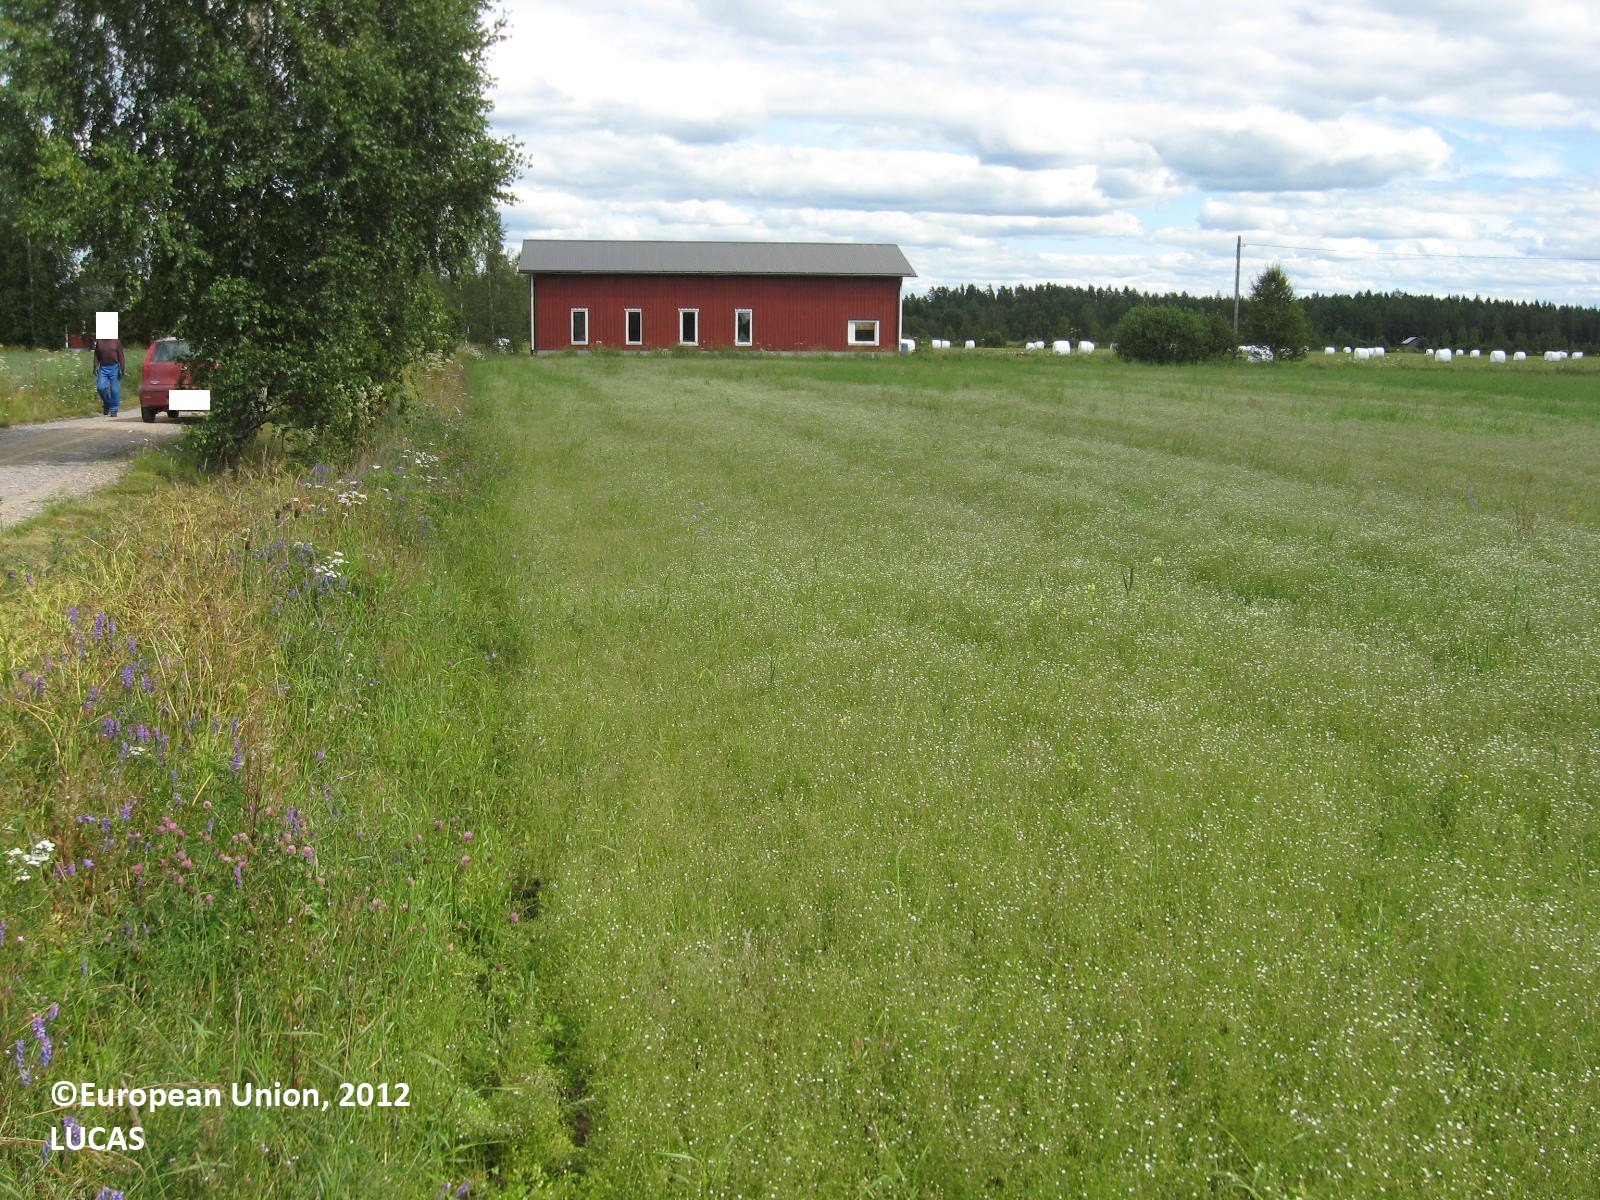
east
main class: Cropland
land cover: Temporary grasslands
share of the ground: > 75 %
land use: Agriculture (excluding fallow land and kitchen gardens)
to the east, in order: Temporary grasslands; Shruby margins; Ditches and canals; Grass margins; Lucerne; Potatoes; Grassland without tree/shrub cover; Mixed cereals for fodder
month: July
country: FI
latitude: 62.0226
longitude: 22.4212
